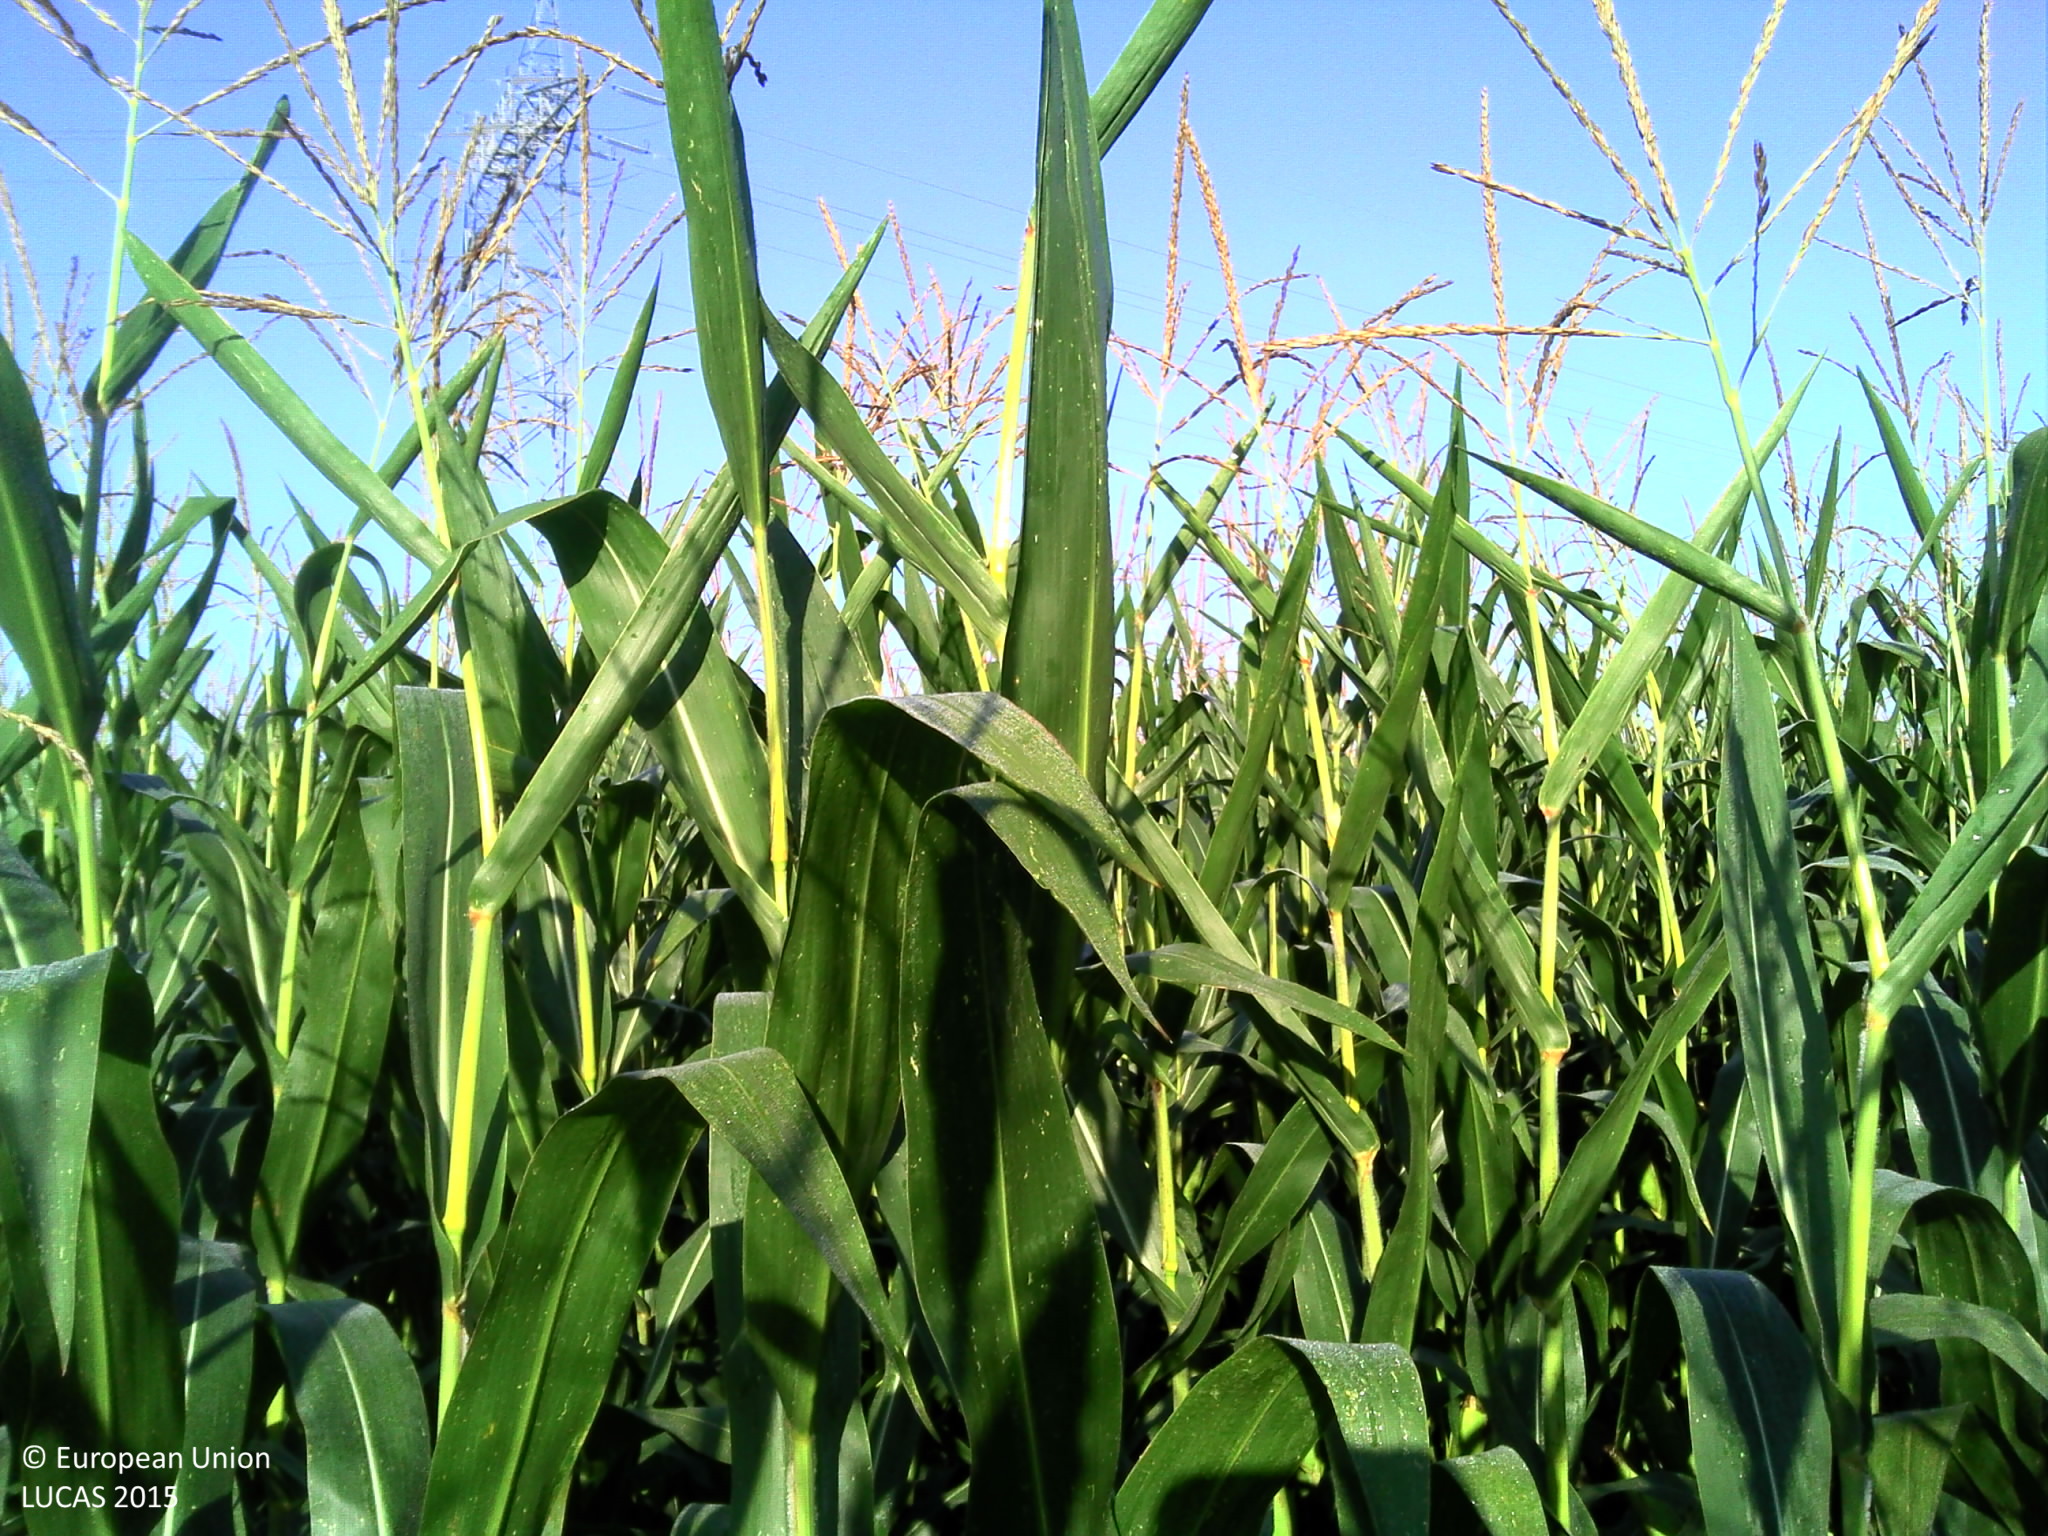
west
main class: Cropland
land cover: Maize
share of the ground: > 75 %
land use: Agriculture (excluding fallow land and kitchen gardens)
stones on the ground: 10 - 25 %
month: September
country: FR
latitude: 43.5242
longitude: -0.6884
